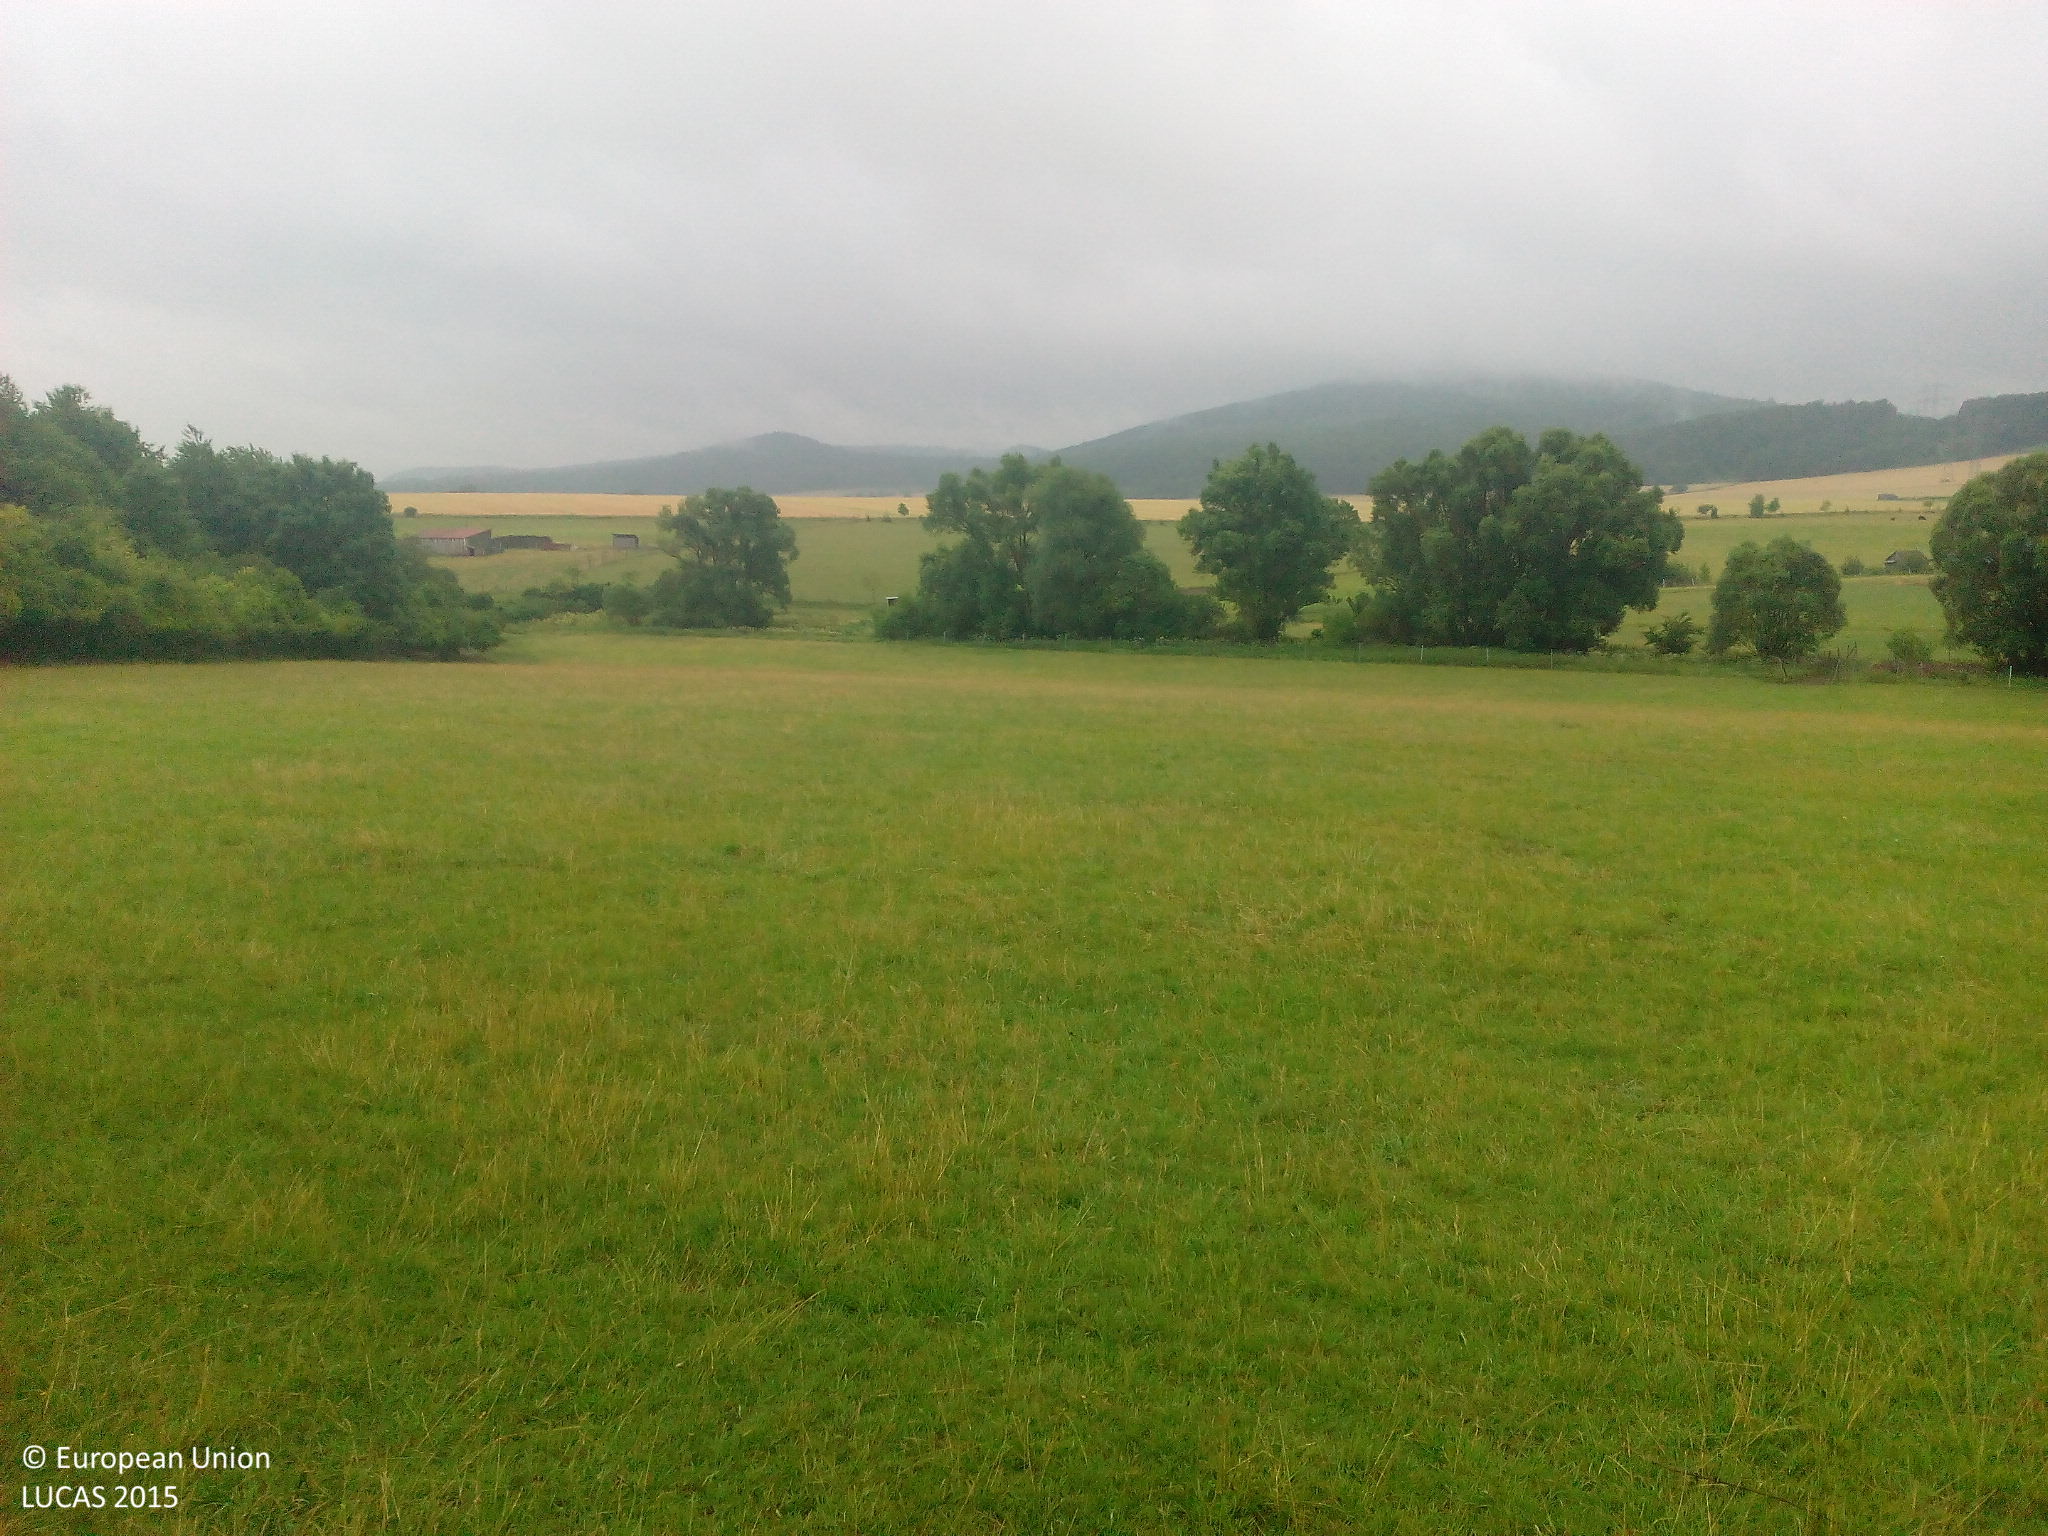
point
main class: Grassland
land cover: Grassland without tree/shrub cover
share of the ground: > 75 %
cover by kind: herbaceous plants 100 %
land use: Agriculture (excluding fallow land and kitchen gardens)
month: July
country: DE
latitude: 50.7415
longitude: 9.8442
